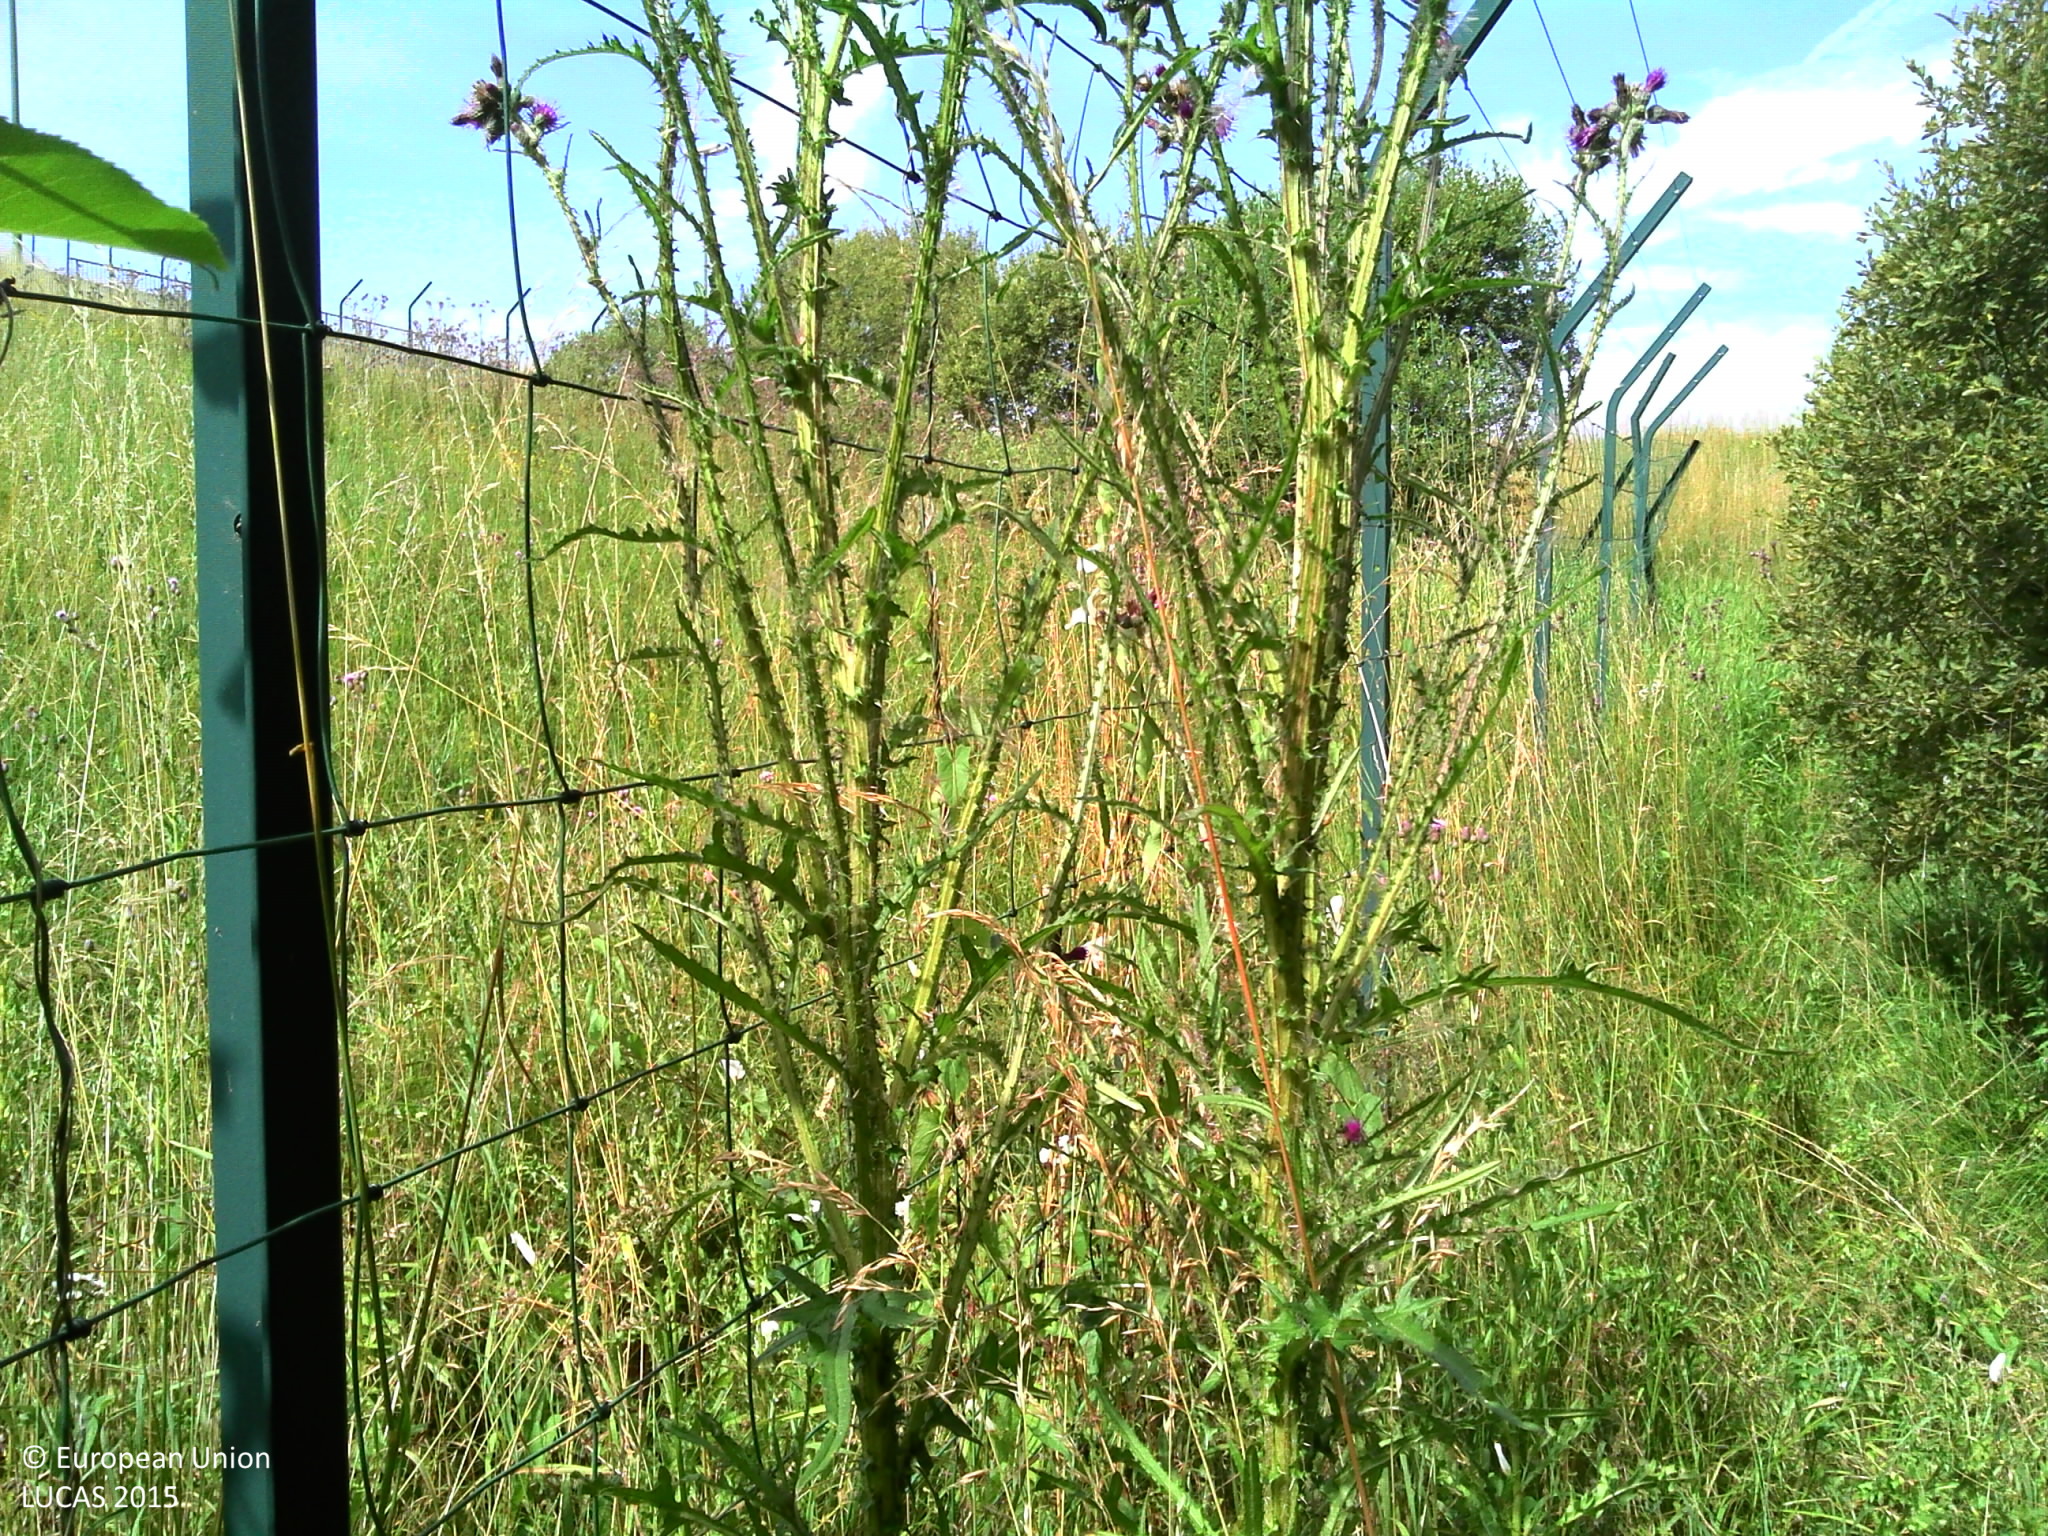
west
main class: Shrubland
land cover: Shrubland without tree cover
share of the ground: 50 - 75 %
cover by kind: shrubs 50 %, herbaceous plants 50 %
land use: Road transport
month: July
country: BE
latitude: 49.6737
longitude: 5.7724
